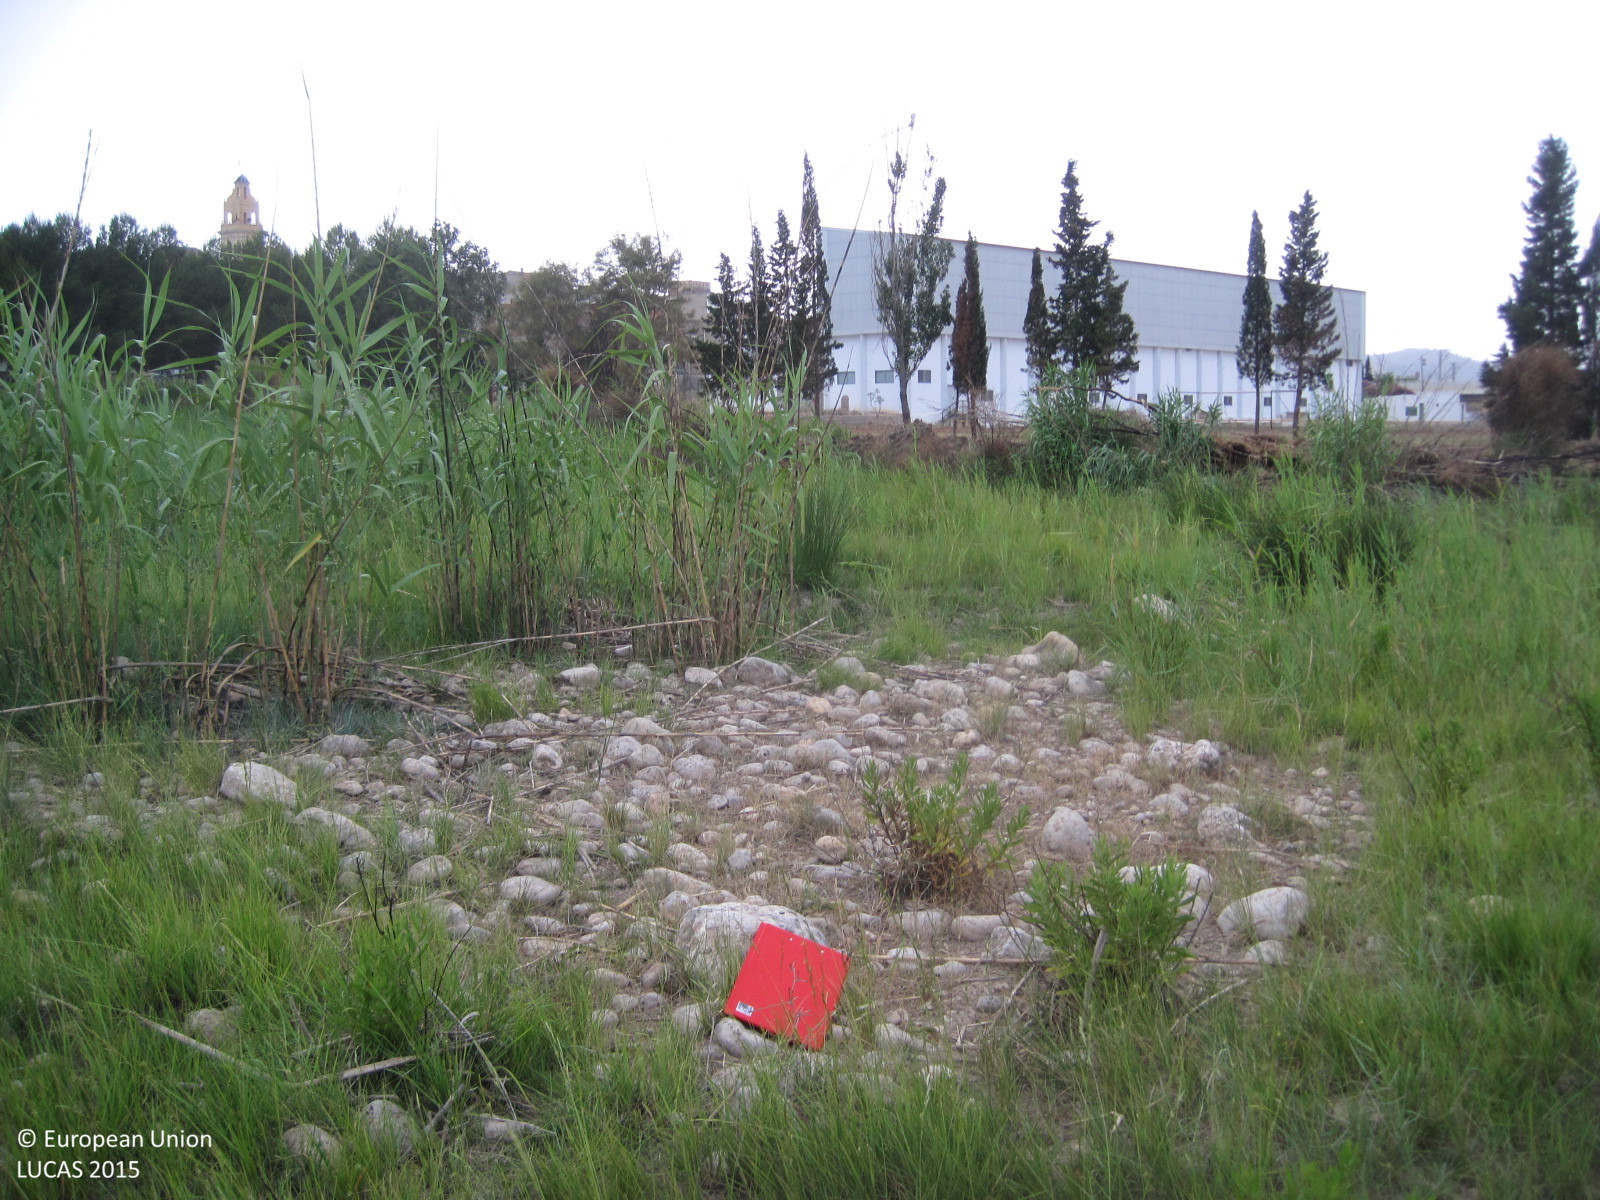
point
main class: Grassland
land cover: Grassland without tree/shrub cover
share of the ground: 50 - 75 %
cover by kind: herbaceous plants 70 %, unconsolidated bare surface 25 %, shrubs 5 %
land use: Semi-natural and natural areas not in use
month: June
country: ES
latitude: 39.2767
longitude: -0.5563
